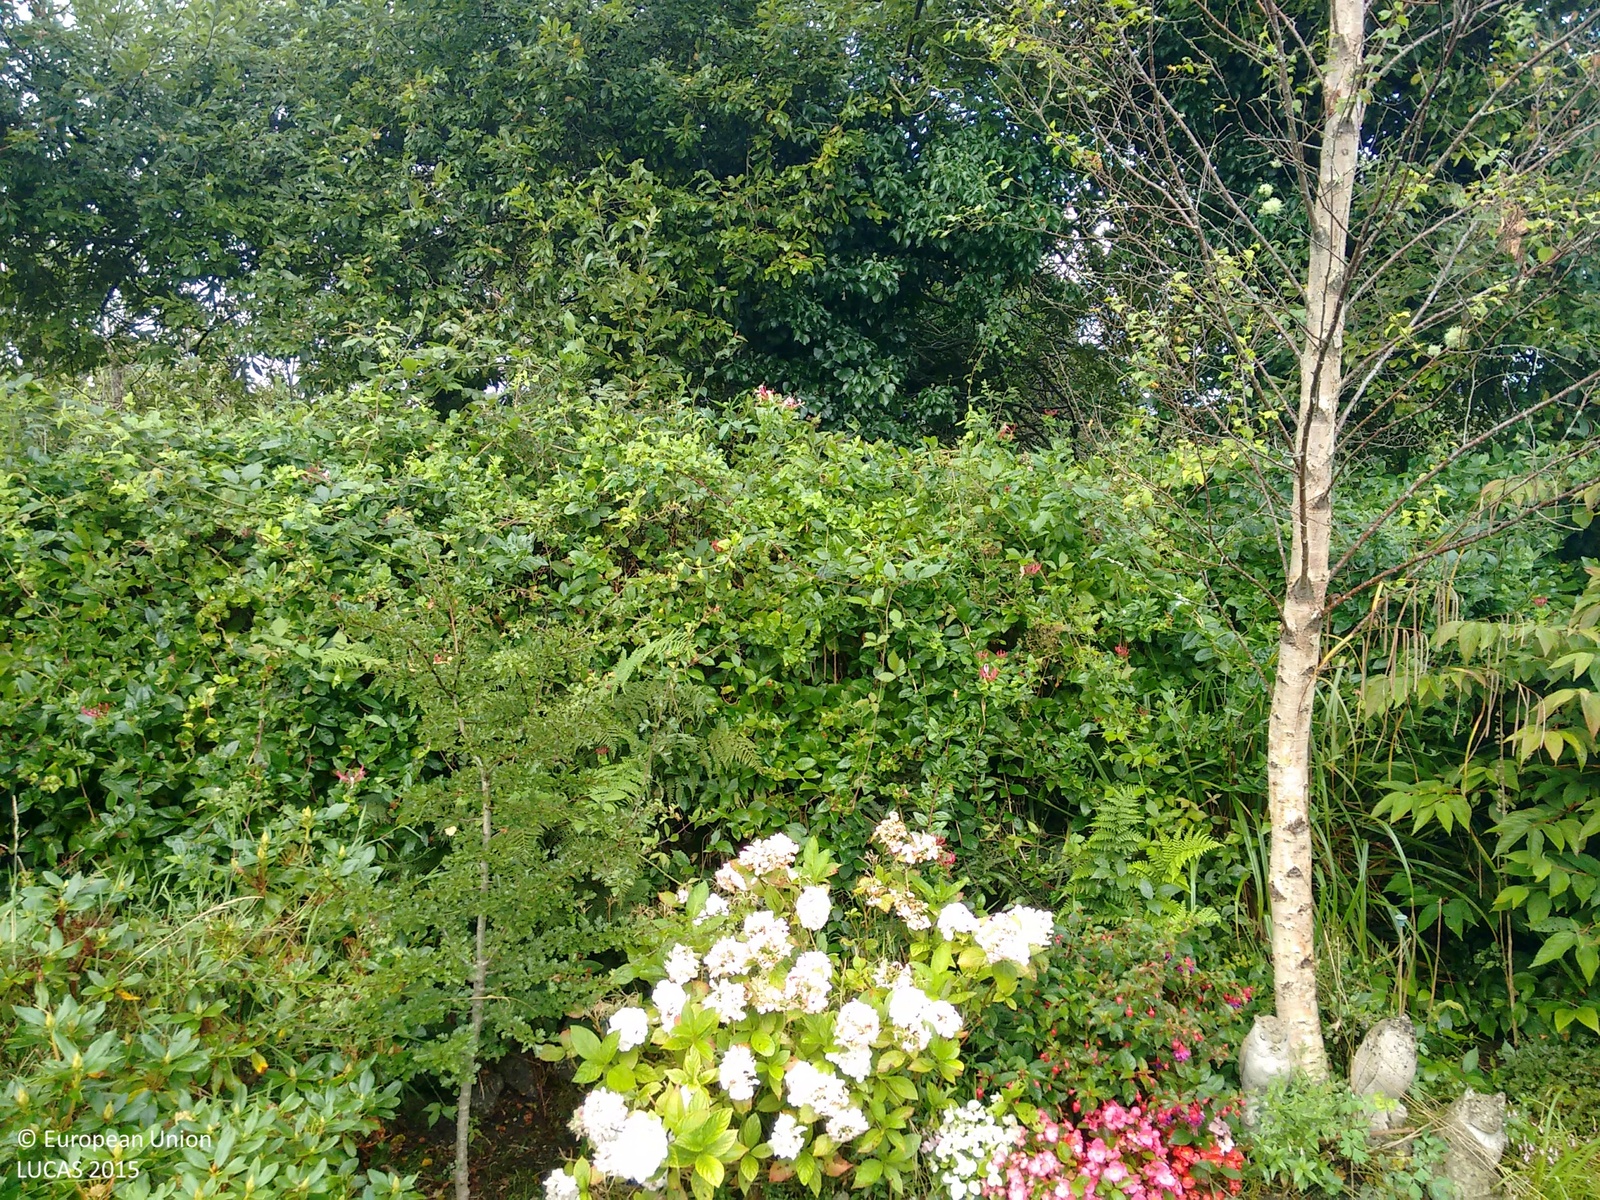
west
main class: Grassland
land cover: Grassland with sparse tree/shrub cover
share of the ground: > 75 %
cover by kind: herbaceous plants 95 %, broadleaved forest trees 5 %
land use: Residential
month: September
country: GB
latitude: 50.2381
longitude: -5.1924
